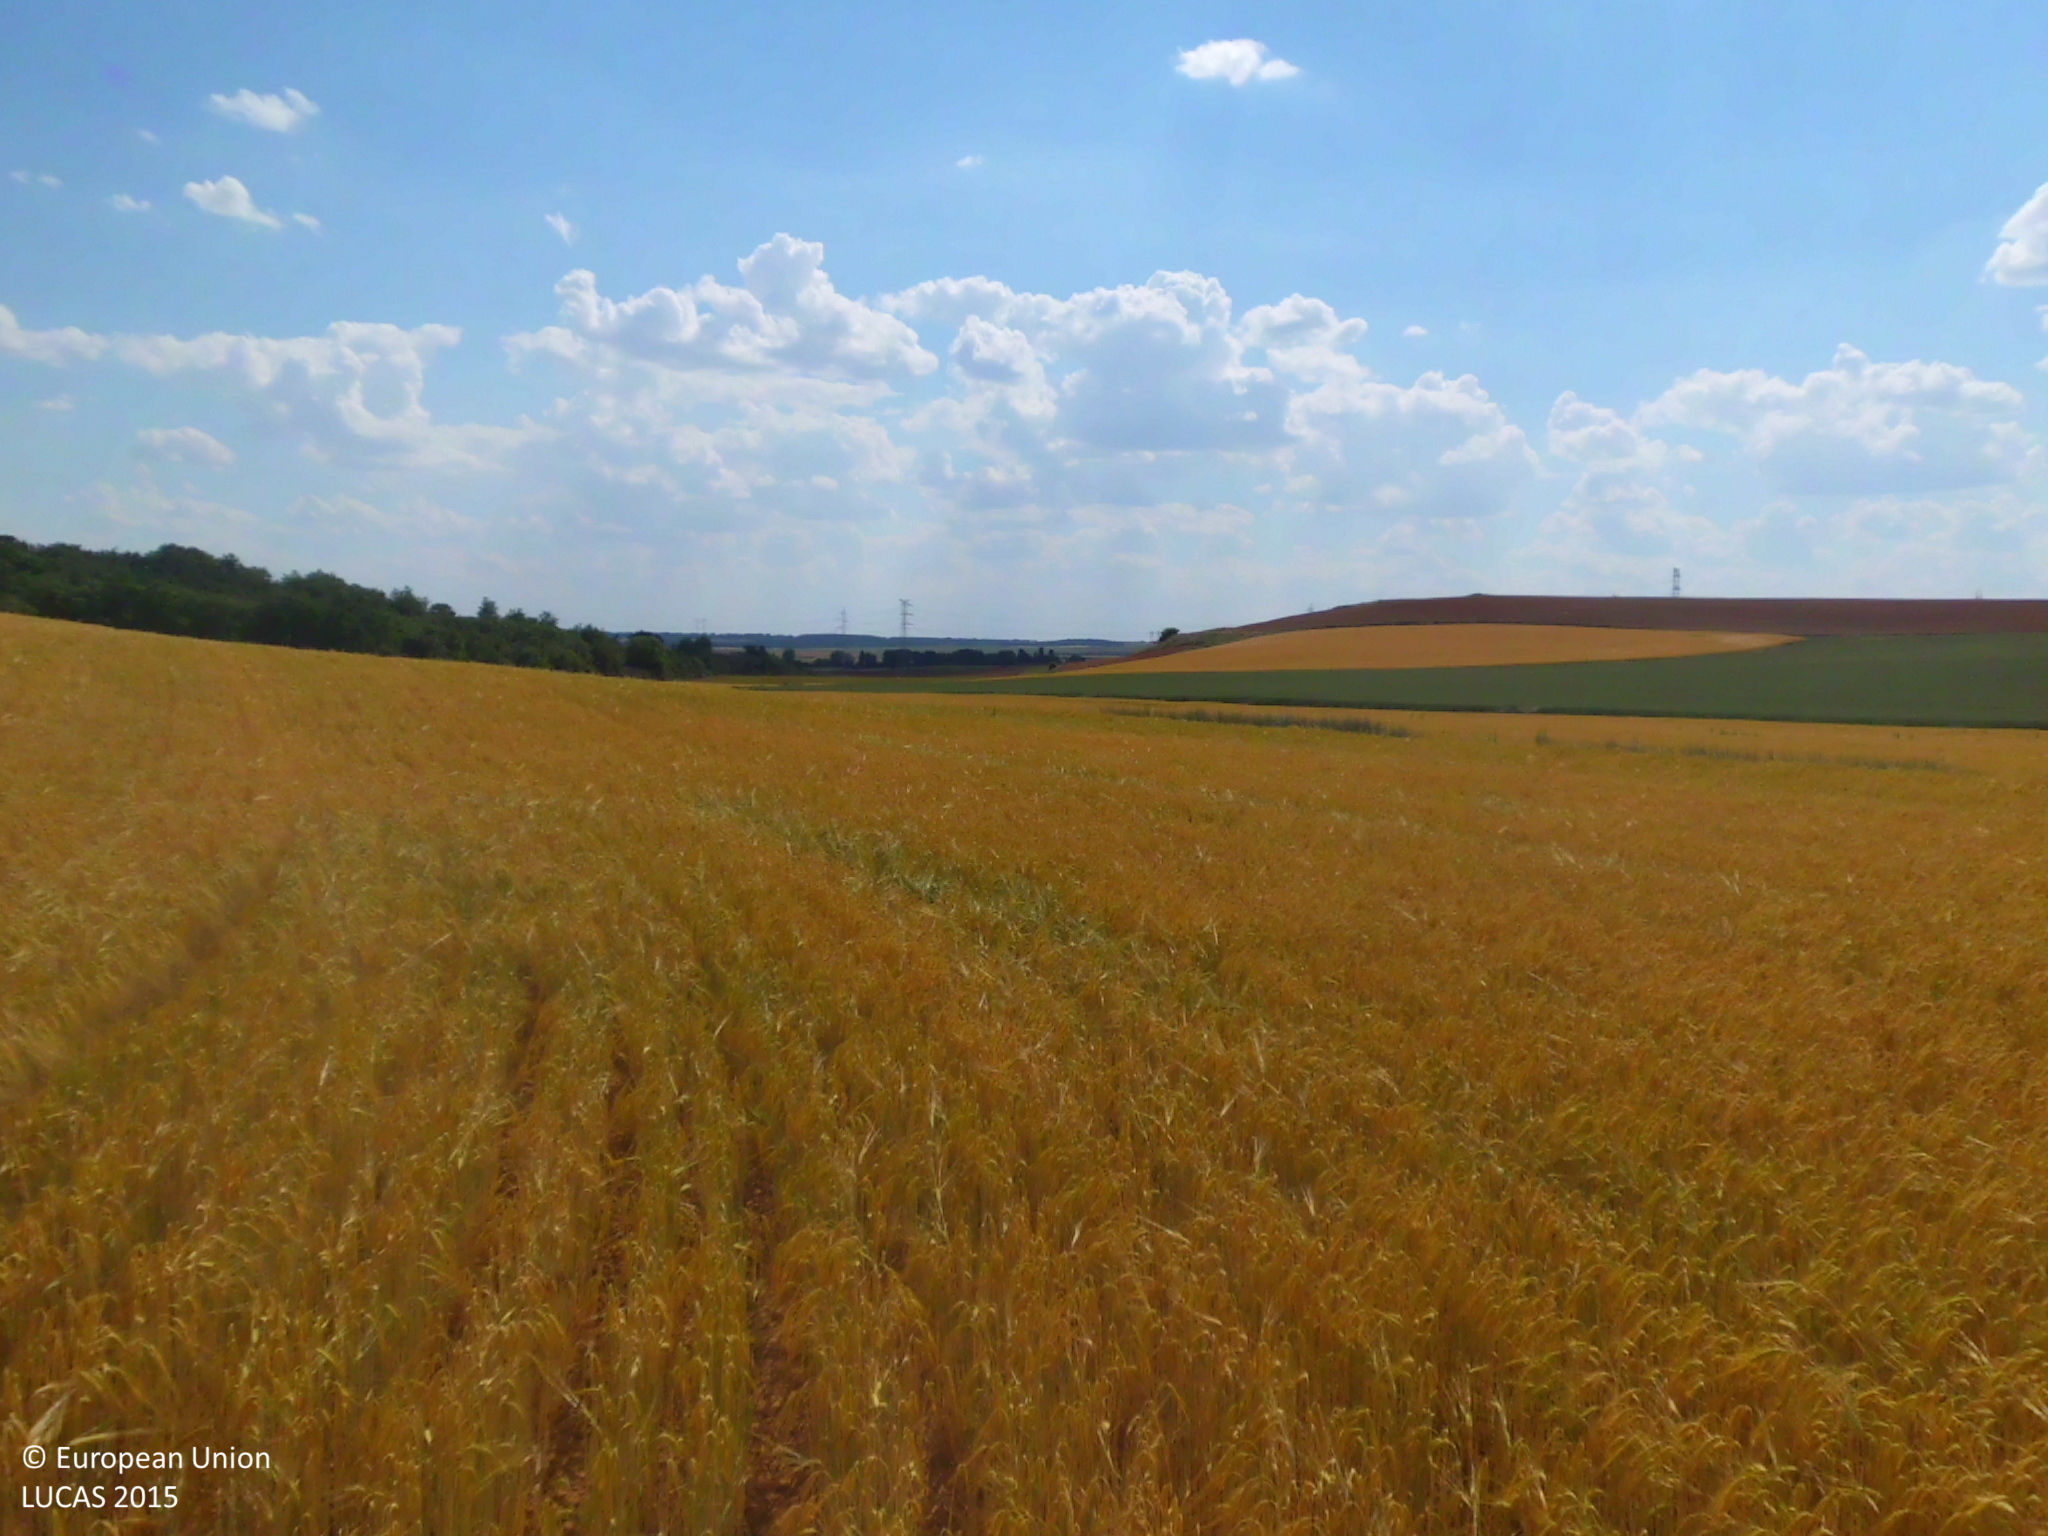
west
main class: Cropland
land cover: Barley
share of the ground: > 75 %
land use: Agriculture (excluding fallow land and kitchen gardens)
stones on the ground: < 10 %
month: June
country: ES
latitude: 42.5232
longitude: -4.3520
